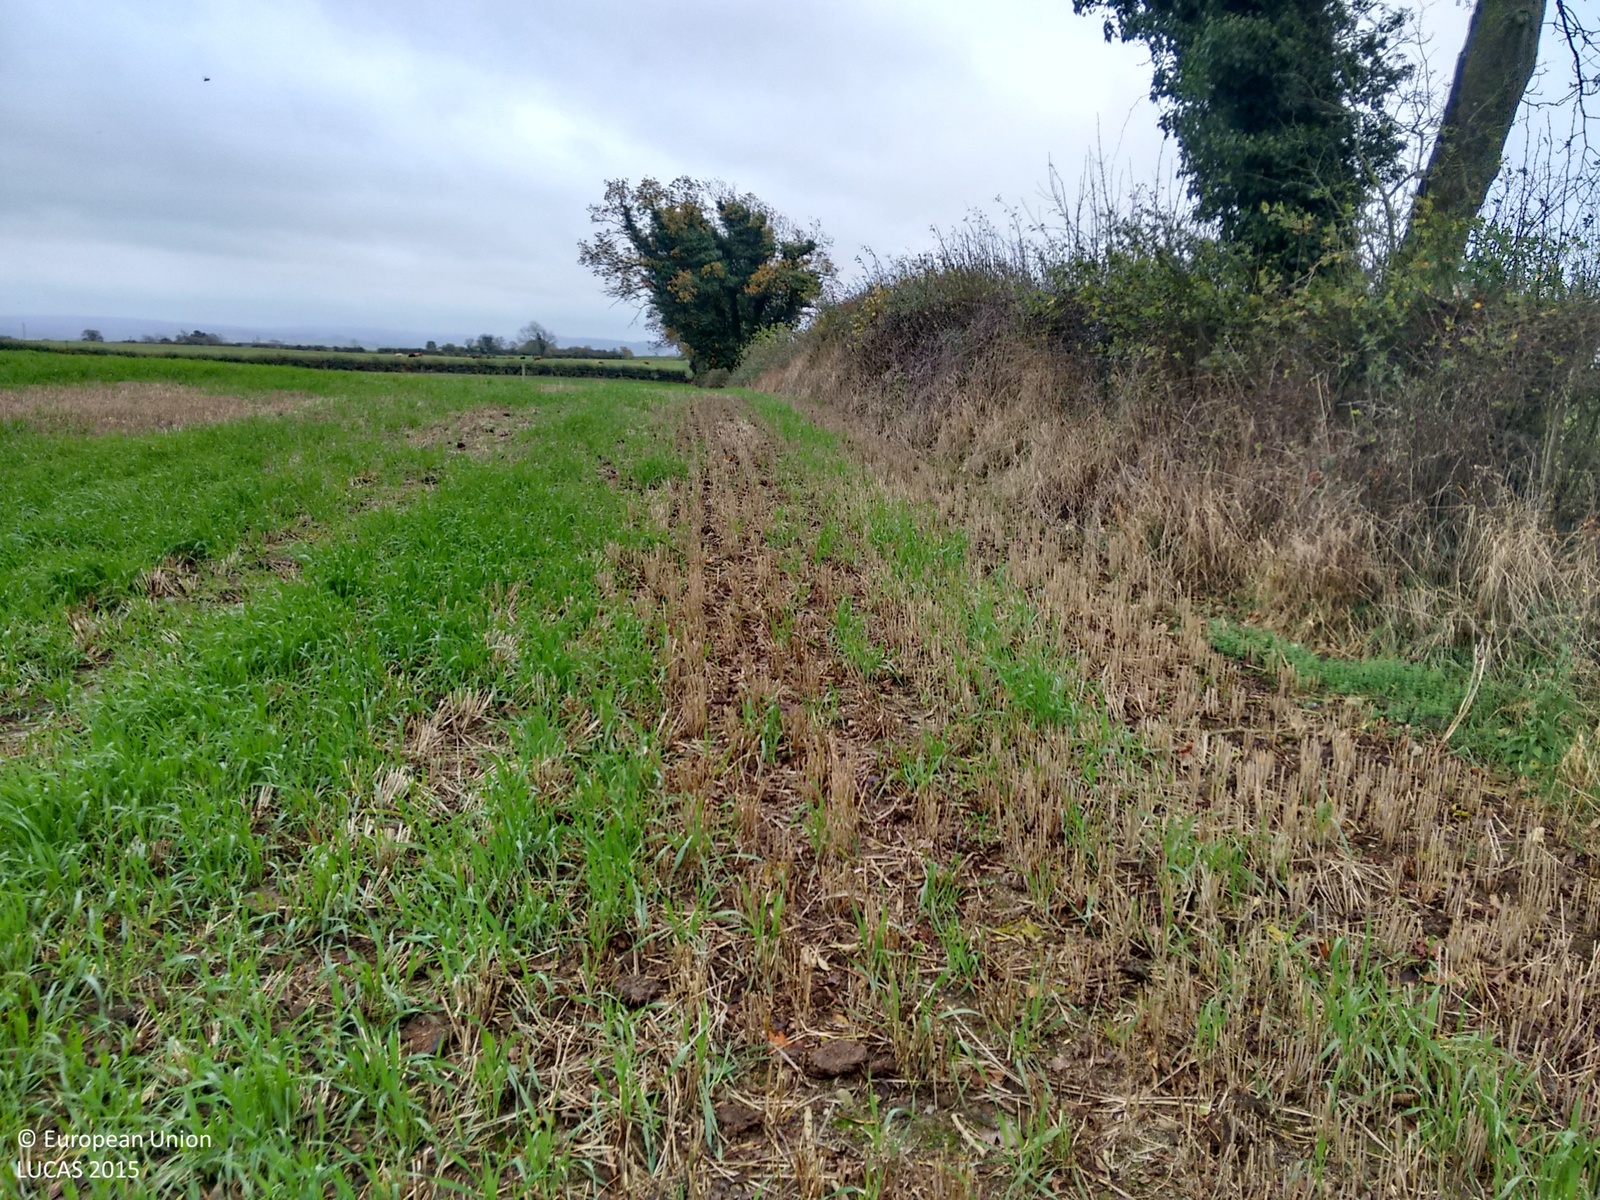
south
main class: Grassland
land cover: Grassland without tree/shrub cover
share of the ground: > 75 %
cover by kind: herbaceous plants 85 %, shrubs 5 %
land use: Agriculture (excluding fallow land and kitchen gardens)
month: November
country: IE
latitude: 53.1901
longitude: -7.6905
